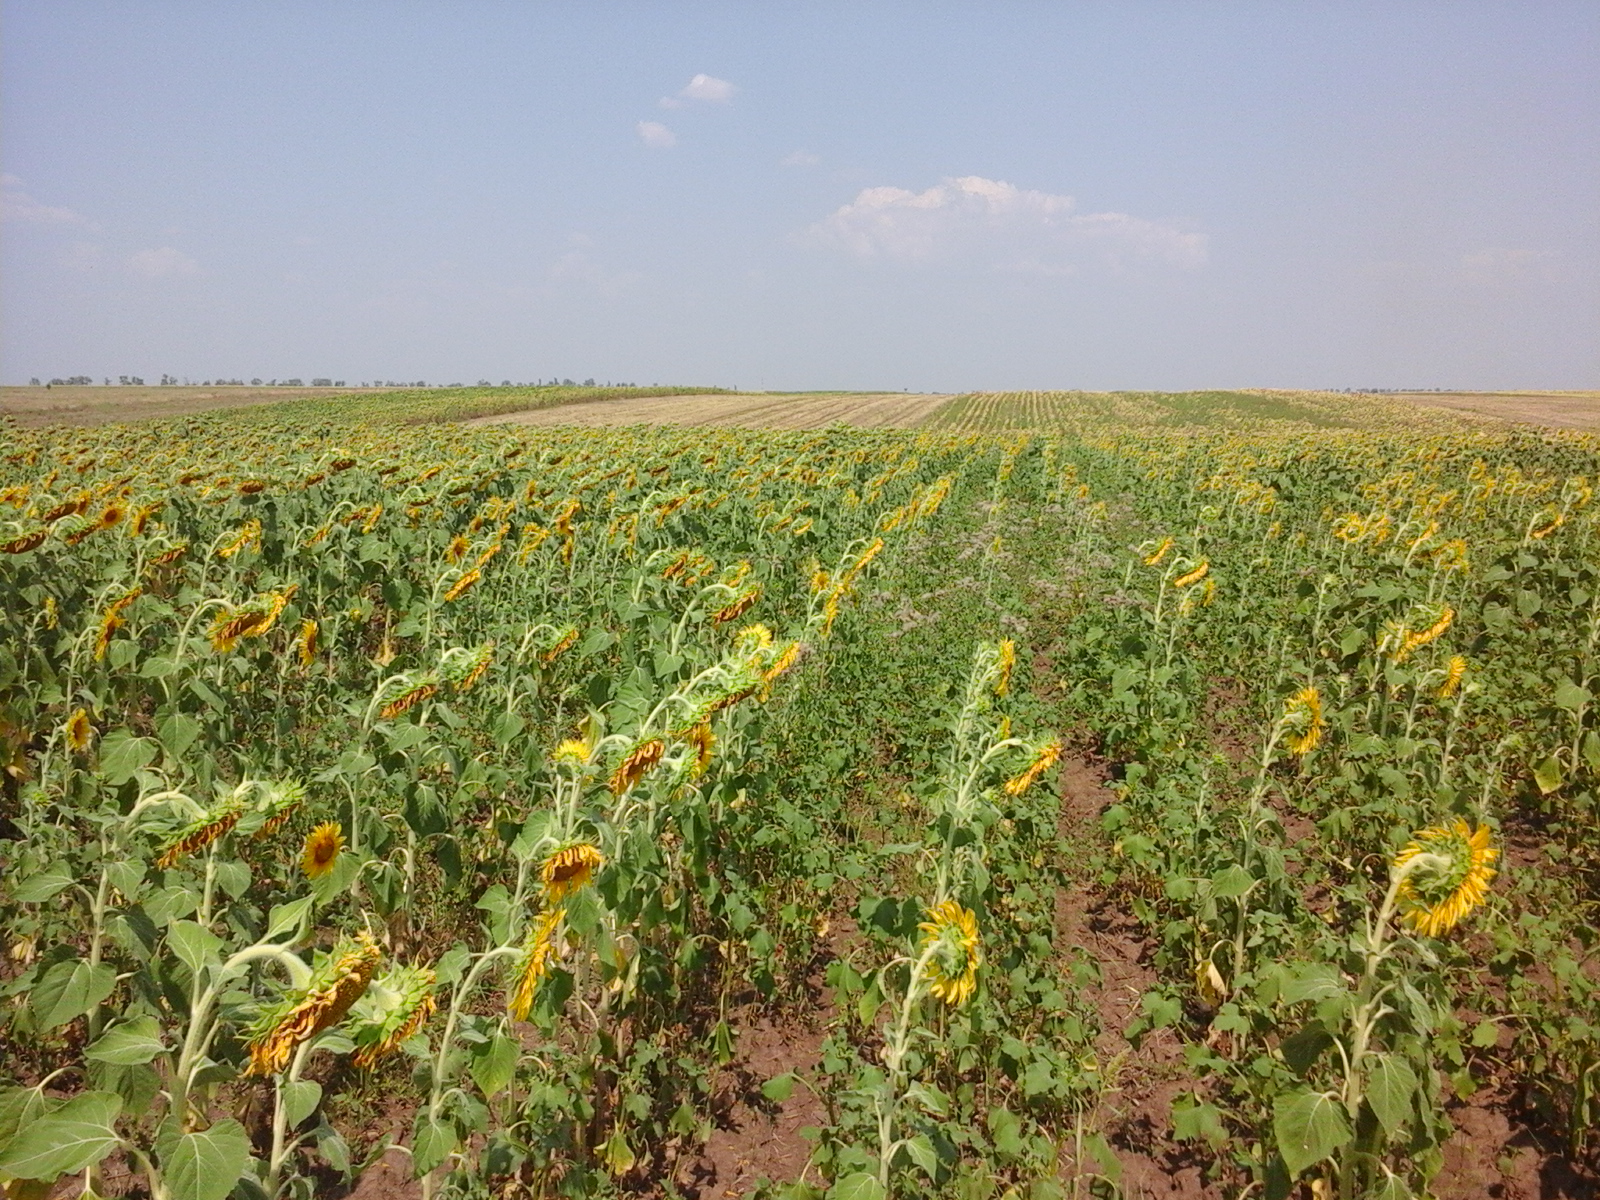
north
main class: Cropland
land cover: Sunflower
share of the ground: > 75 %
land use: Agriculture (excluding fallow land and kitchen gardens)
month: August
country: RO
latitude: 44.2249
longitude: 23.4065
